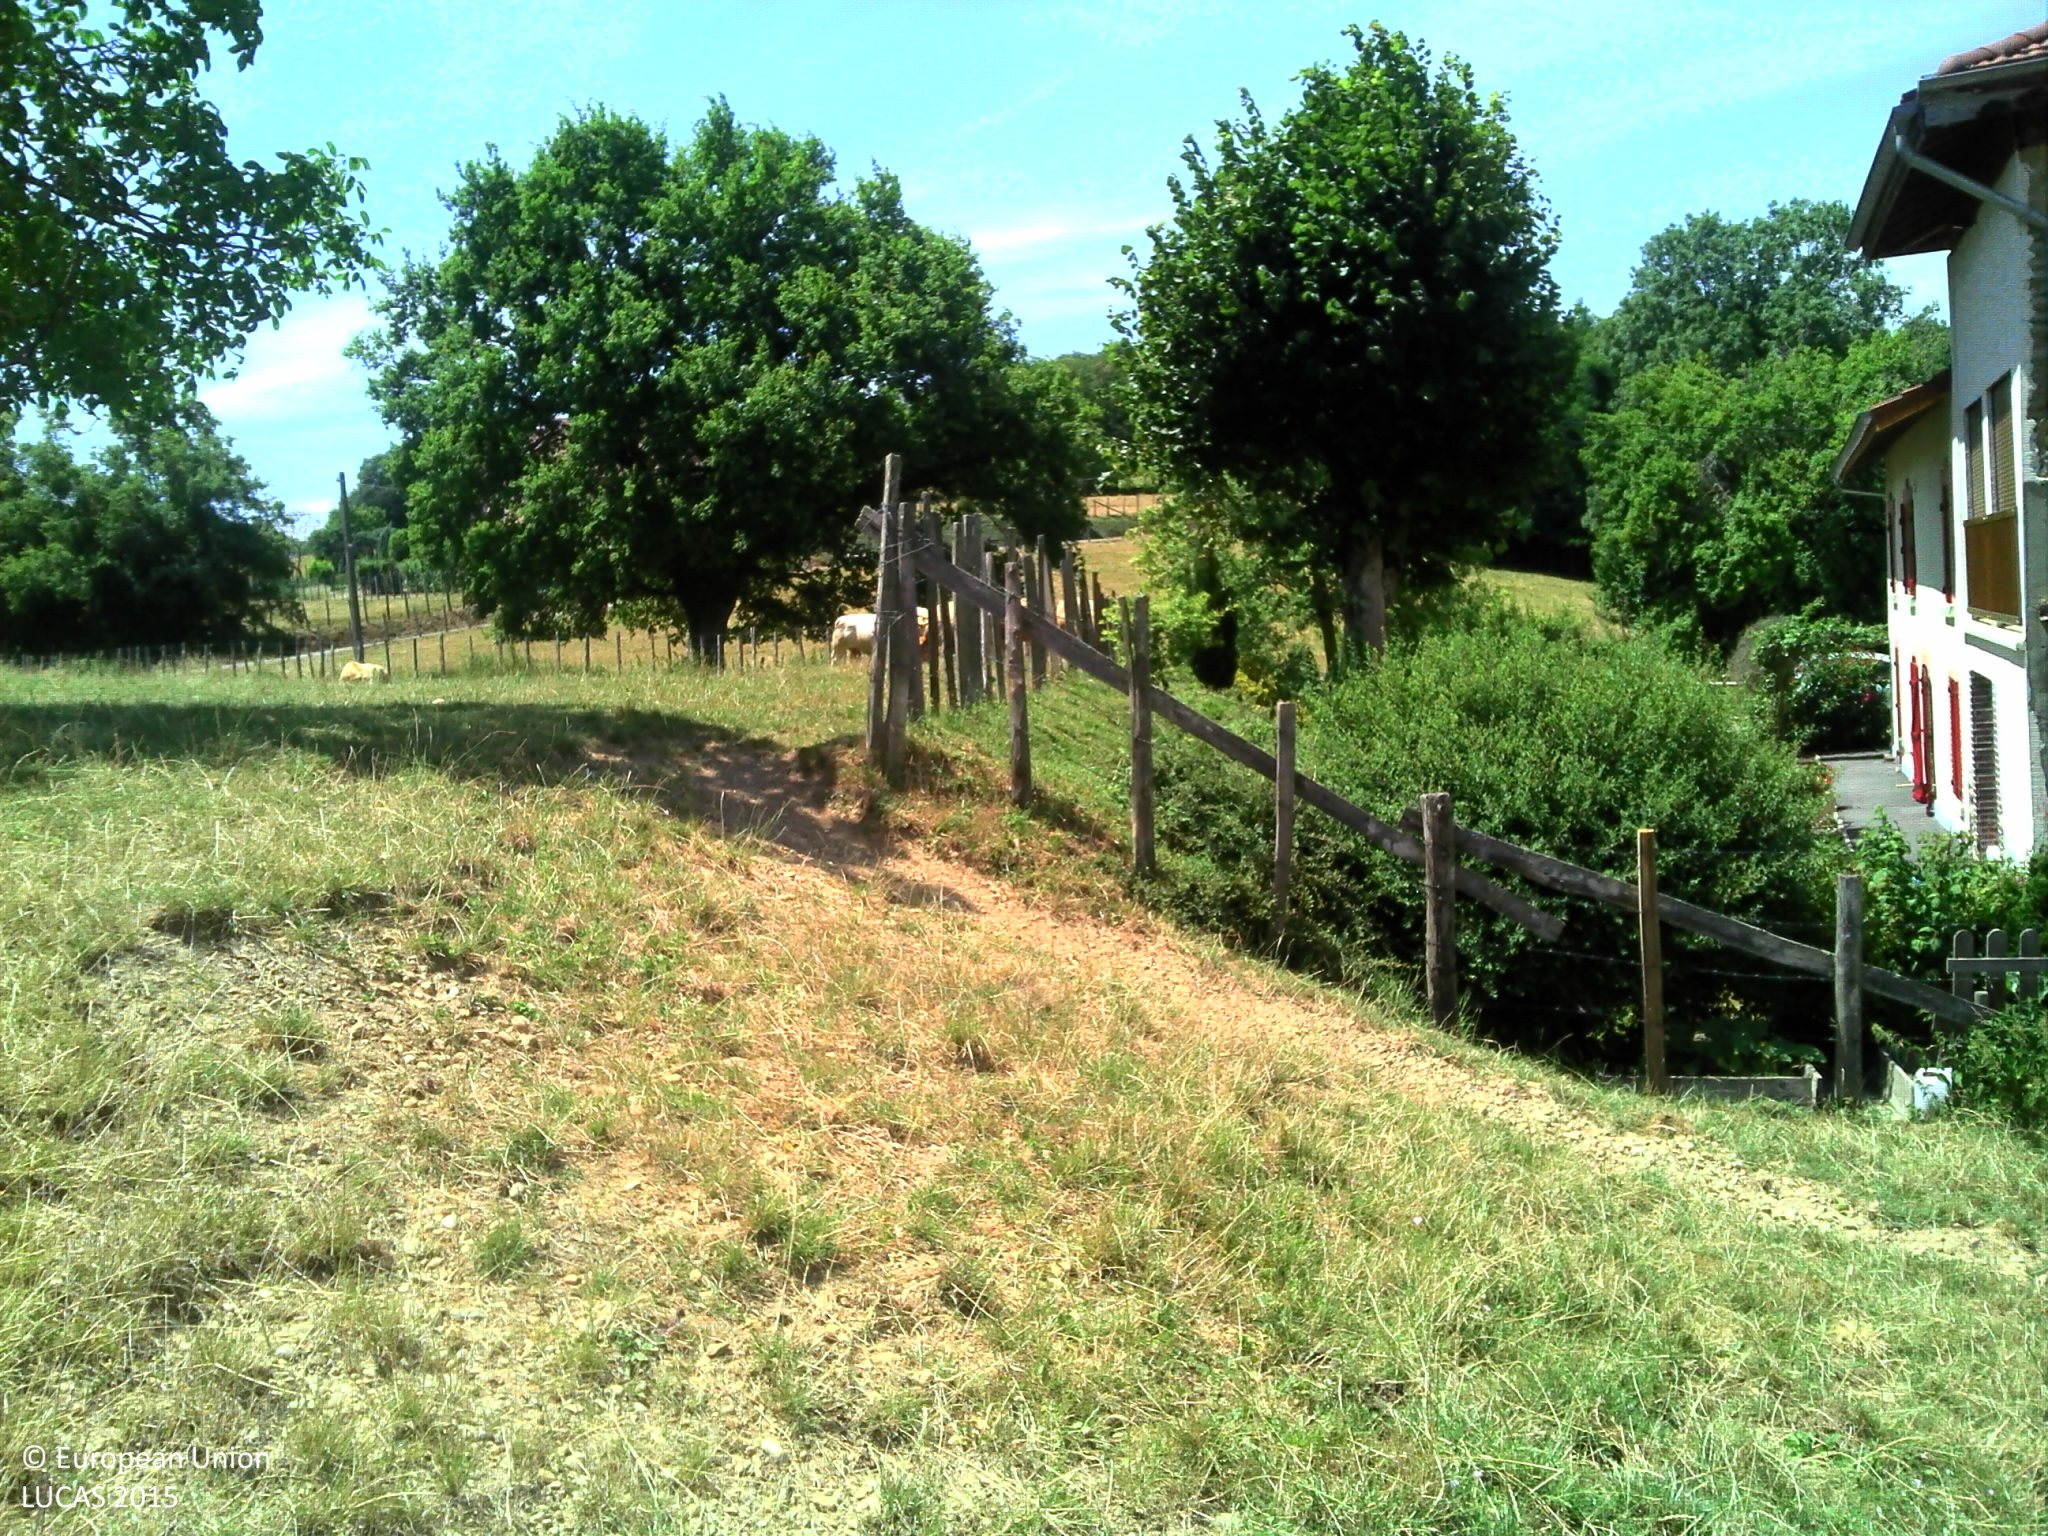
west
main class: Grassland
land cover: Grassland with sparse tree/shrub cover
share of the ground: > 75 %
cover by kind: herbaceous plants 90 %, broadleaved forest trees 5 %, consolidated bare surface 5 %
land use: Agriculture (excluding fallow land and kitchen gardens)
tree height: > 5 m
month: July
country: FR
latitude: 45.3049
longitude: 5.1968
